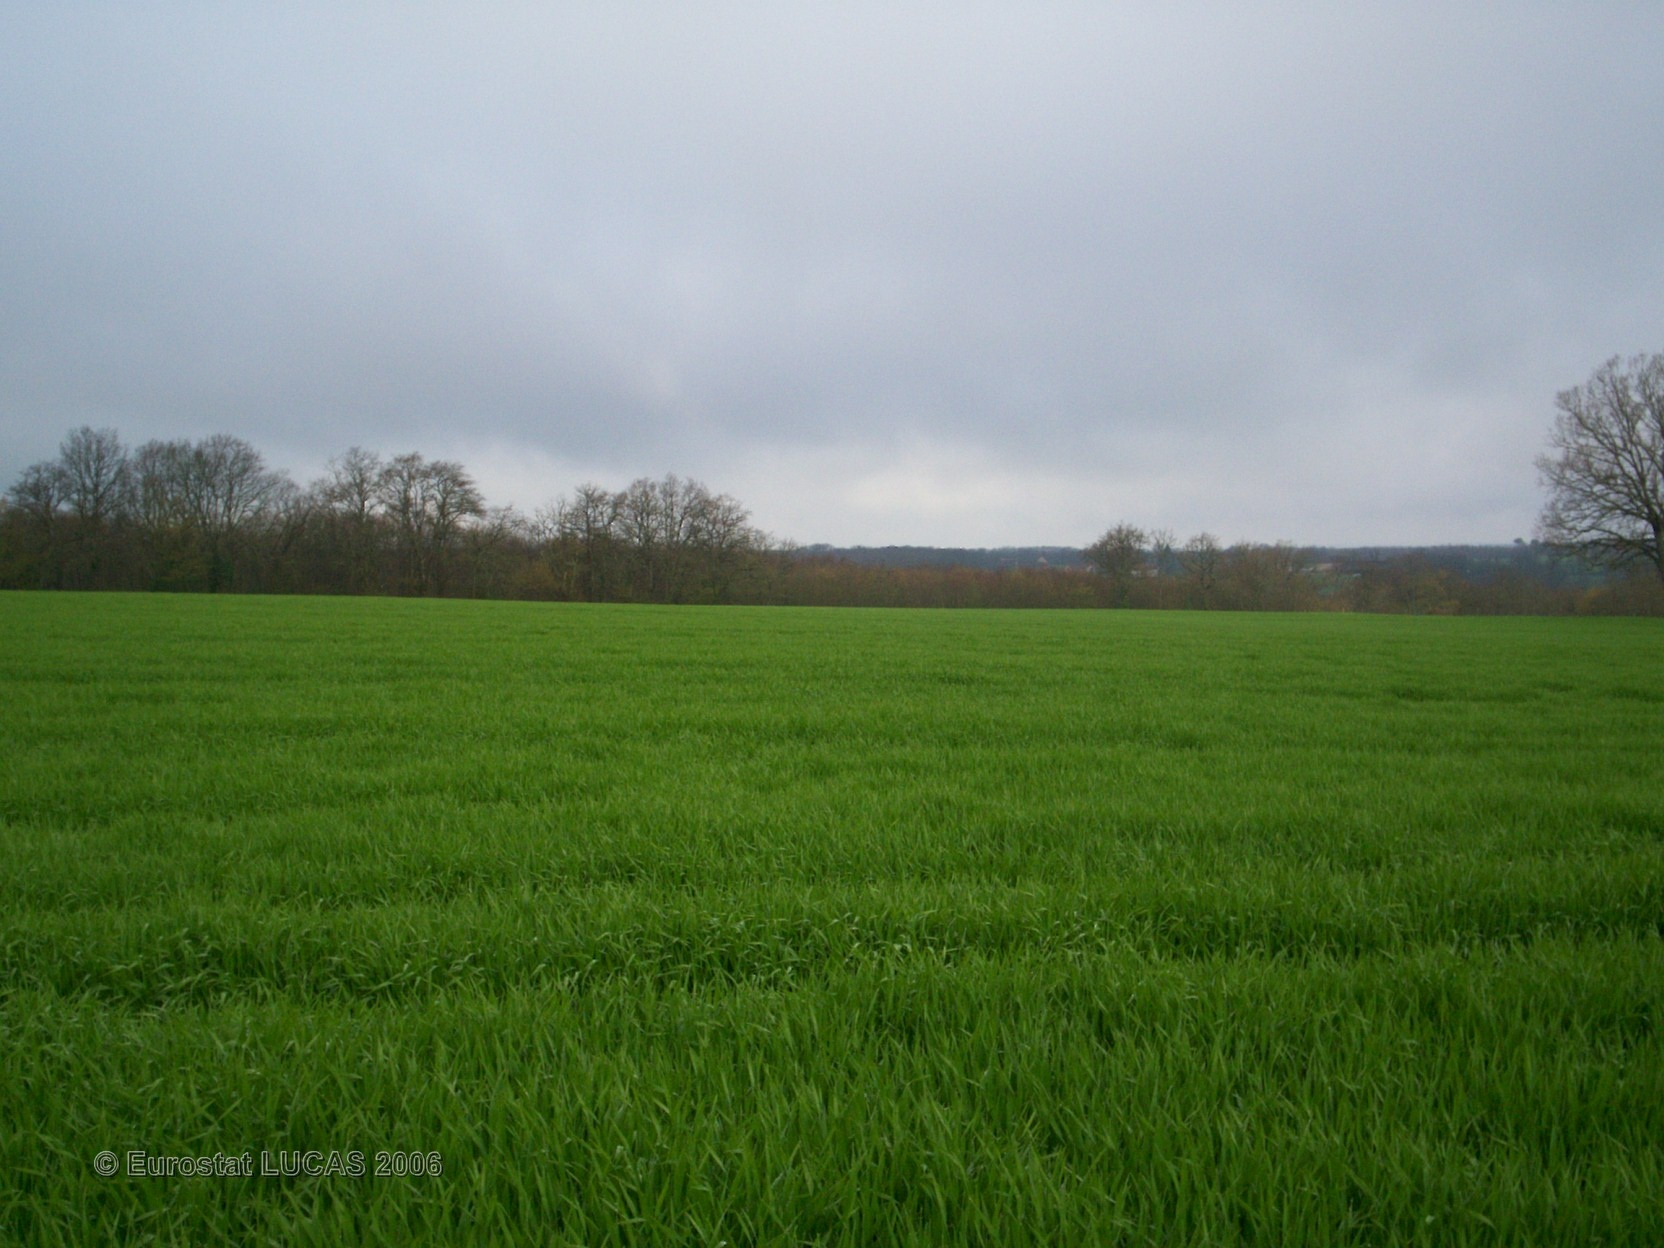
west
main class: Cropland
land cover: Common wheat
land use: Agriculture (excluding fallow land and kitchen gardens)
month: April
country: FR
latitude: 46.3880
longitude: 1.0013
